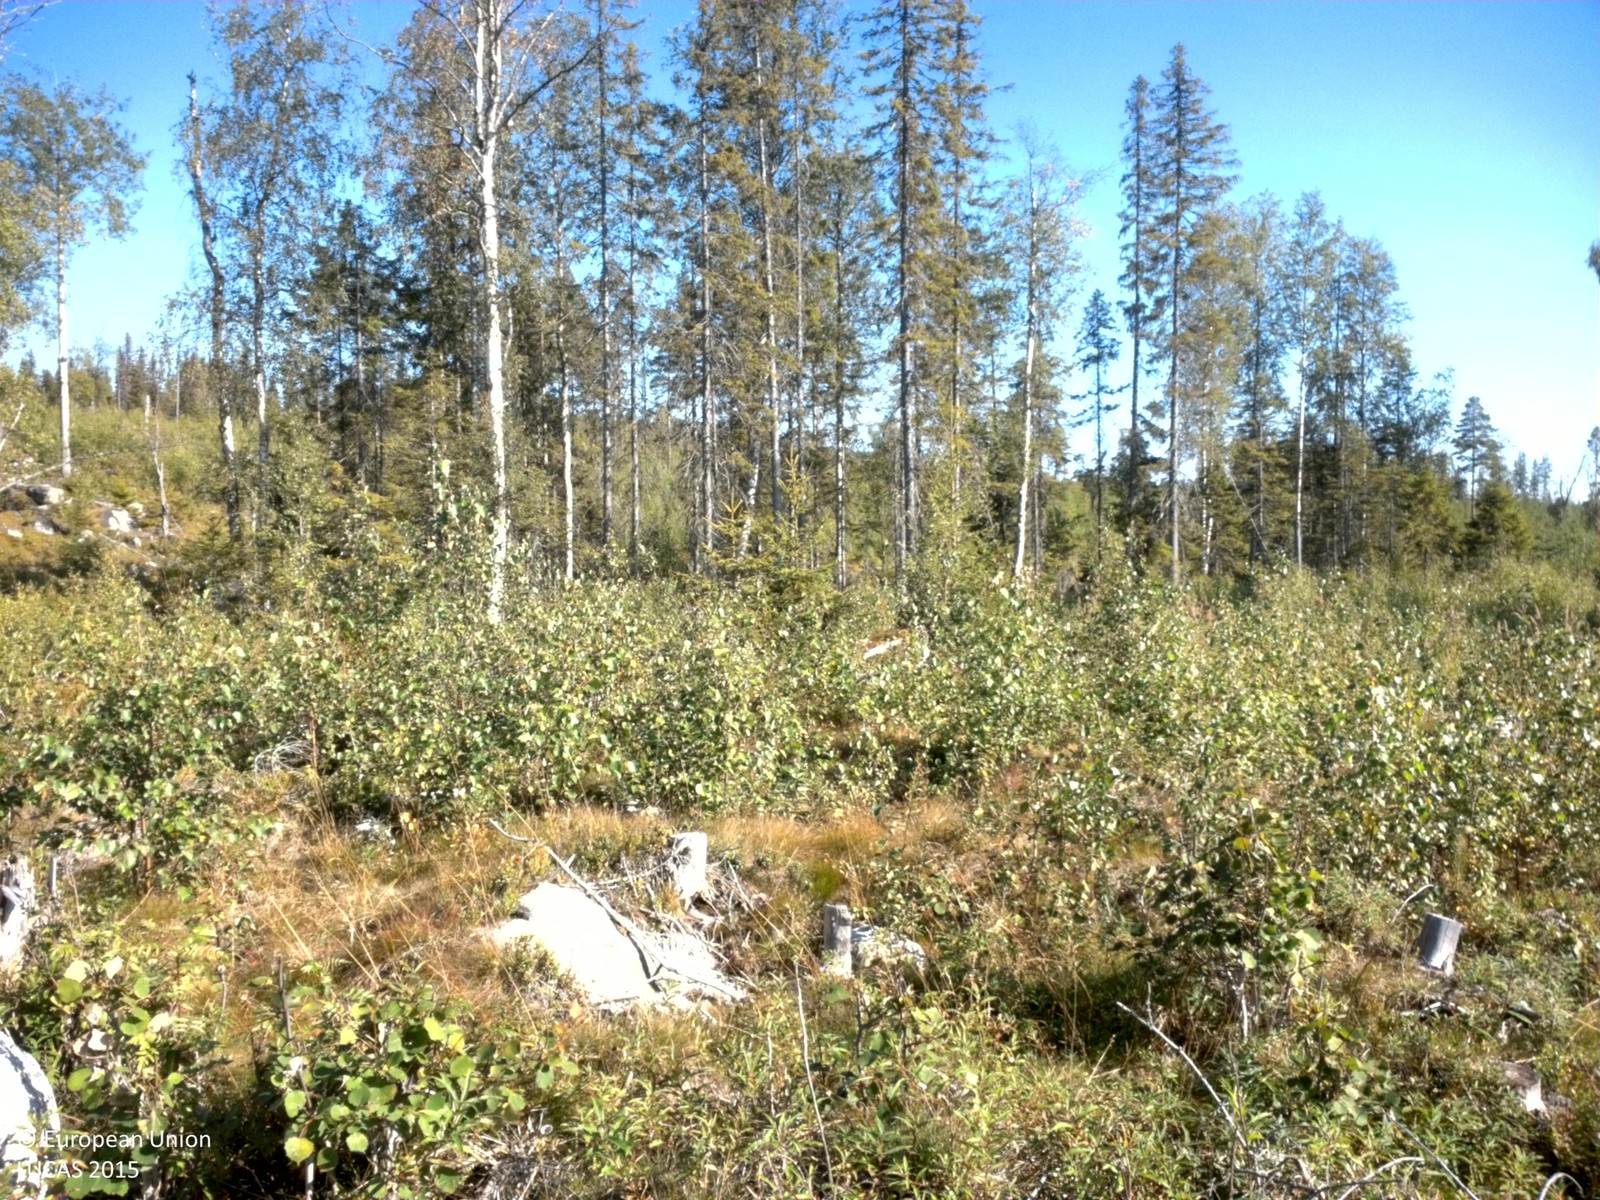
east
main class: Woodland
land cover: Broadleaved woodland
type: boreal forest
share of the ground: 25 - 50 %
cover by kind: shrubs 50 %, broadleaved forest trees 40 %, coniferous forest trees 5 %, herbaceous plants 5 %
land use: Forestry
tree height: < 5 m
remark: Clear cut
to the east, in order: Broadleaved woodland; Other mixed woodland; Spruce dominated mixed woodland
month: August
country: SE
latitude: 64.3058
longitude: 19.0050
